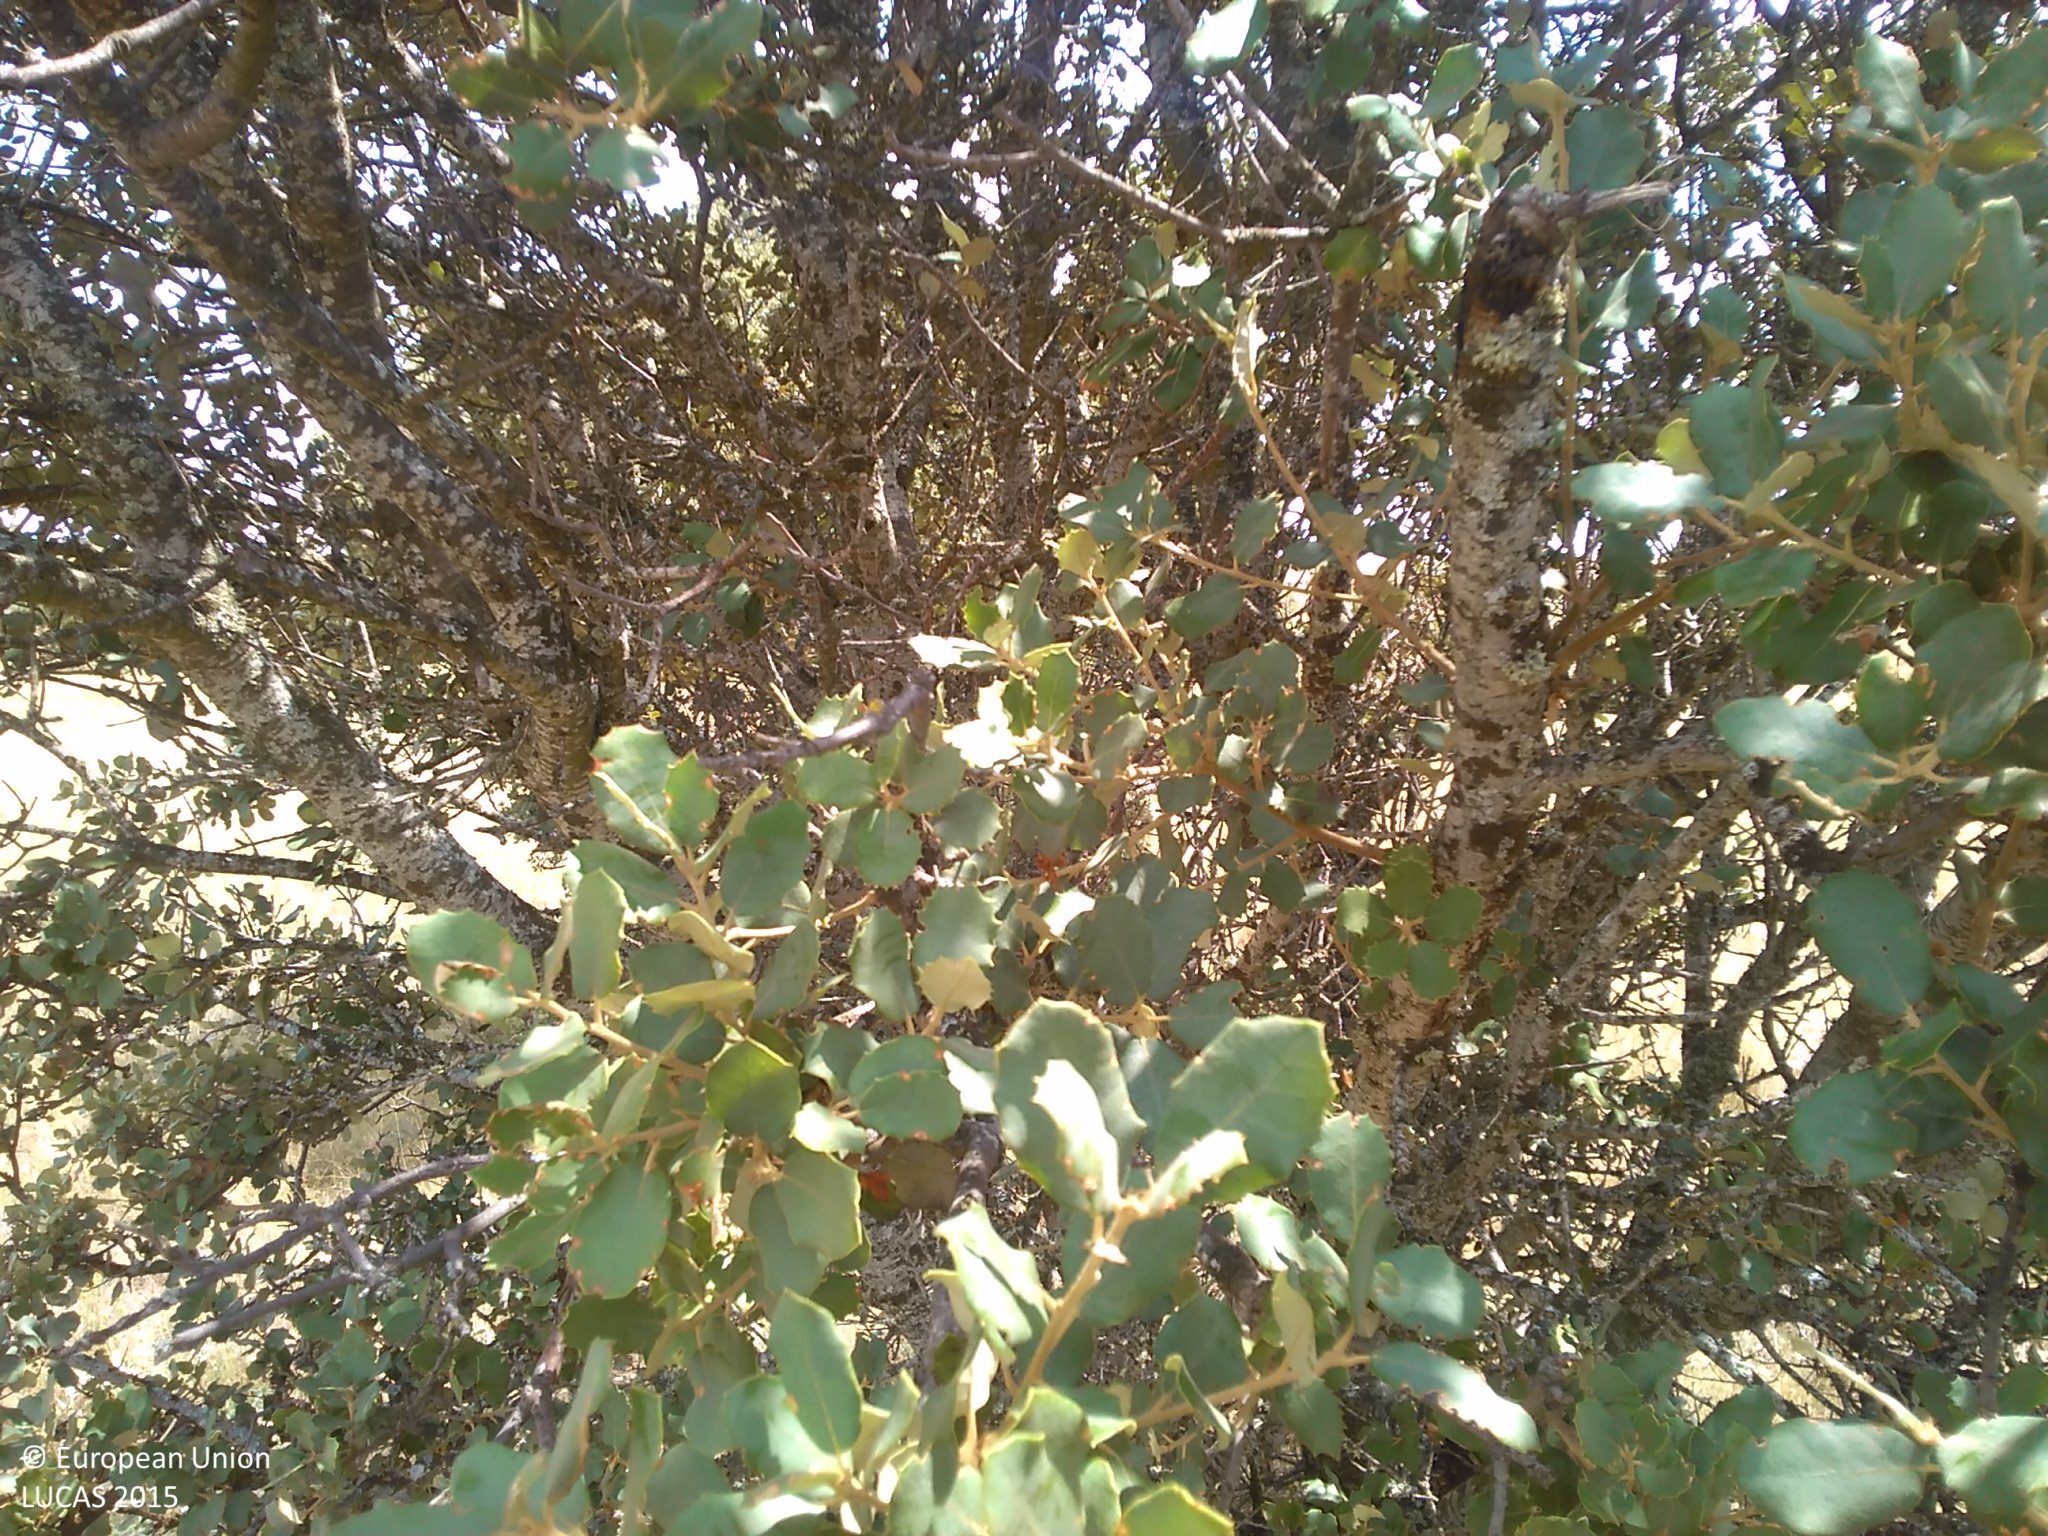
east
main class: Grassland
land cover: Grassland with sparse tree/shrub cover
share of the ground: 10 - 25 %
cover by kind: herbaceous plants 70 %, unconsolidated bare surface 20 %, broadleaved forest trees 5 %, shrubs 5 %
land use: Semi-natural and natural areas not in use
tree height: < 5 m
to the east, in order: Grassland with sparse tree/shrub cover; Grassland without tree/shrub cover; Tracks; Shrubland with sparse tree cover
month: July
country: ES
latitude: 41.7741
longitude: -2.2950
